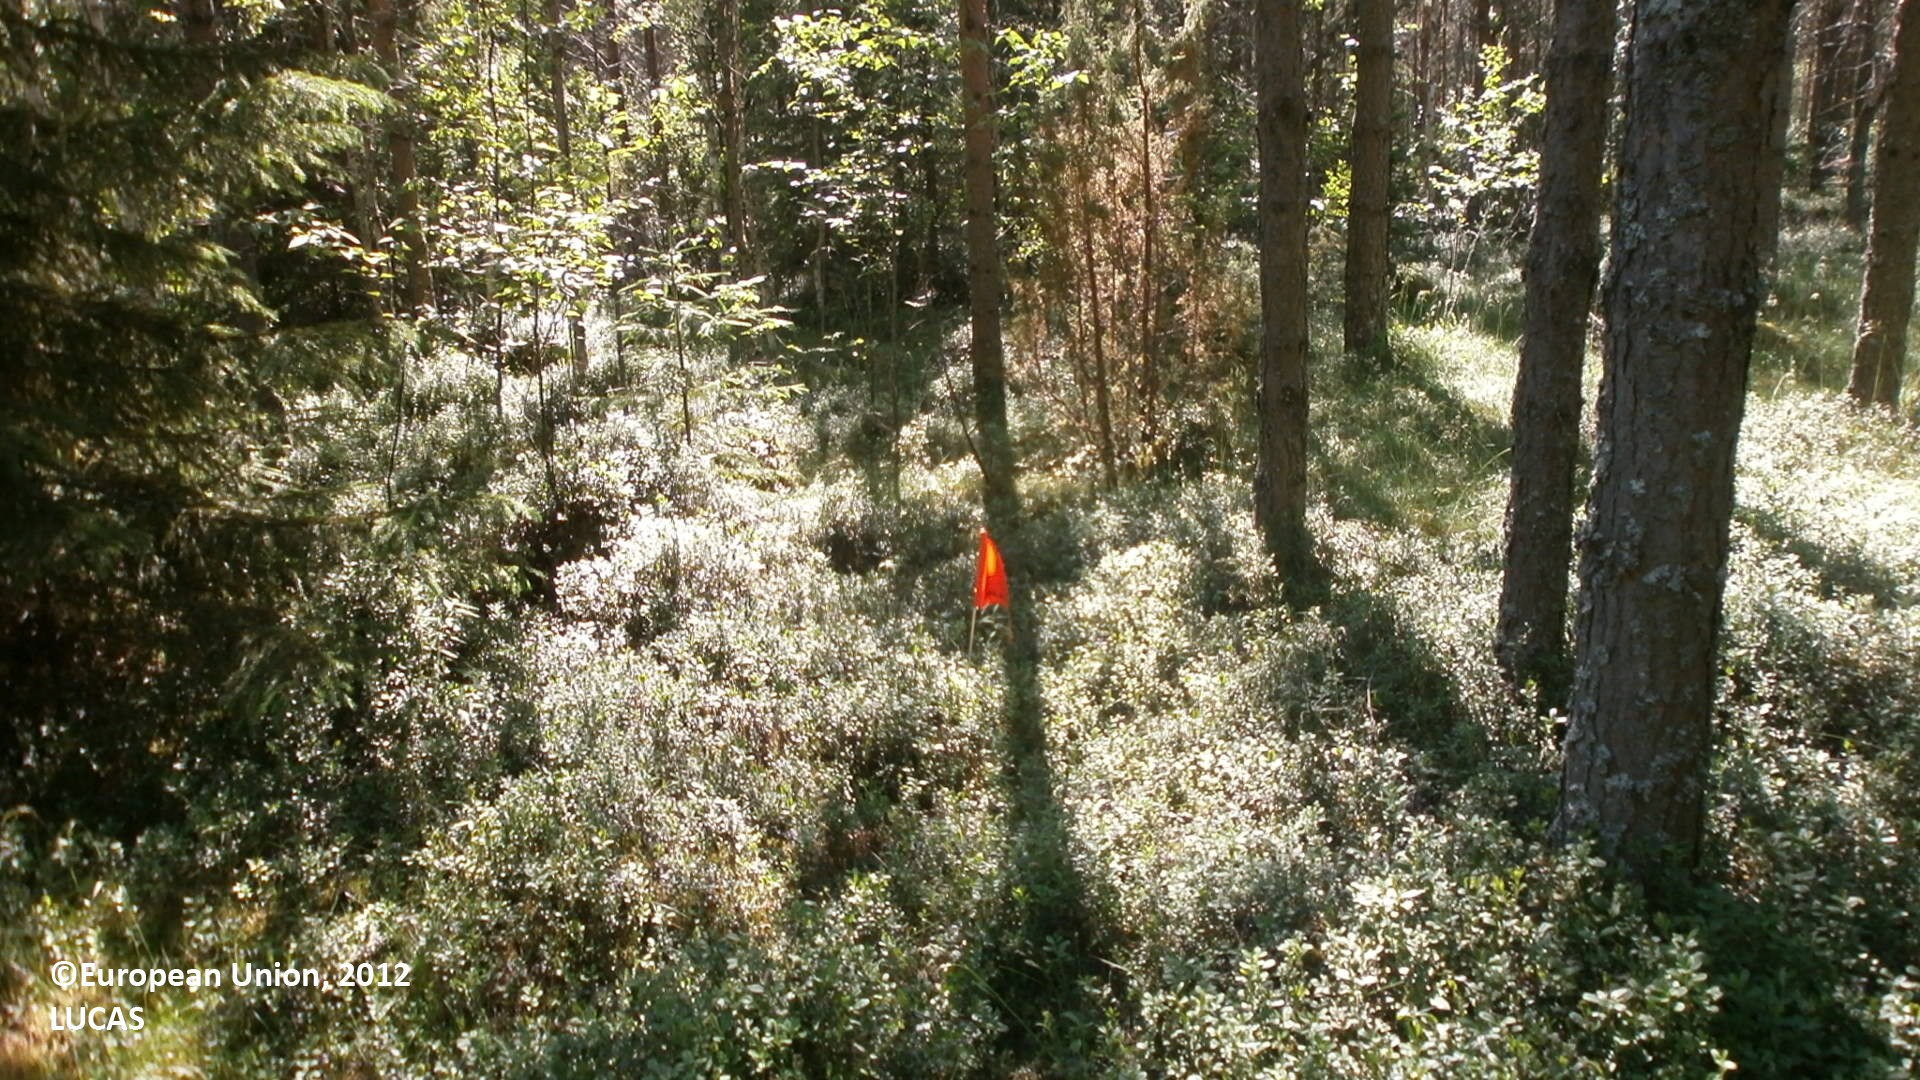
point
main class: Woodland
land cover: Pine dominated mixed woodland
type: boreal forest
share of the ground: 50 - 75 %
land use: Forestry
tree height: > 5 m
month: July
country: FI
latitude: 64.3235
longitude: 24.0249
